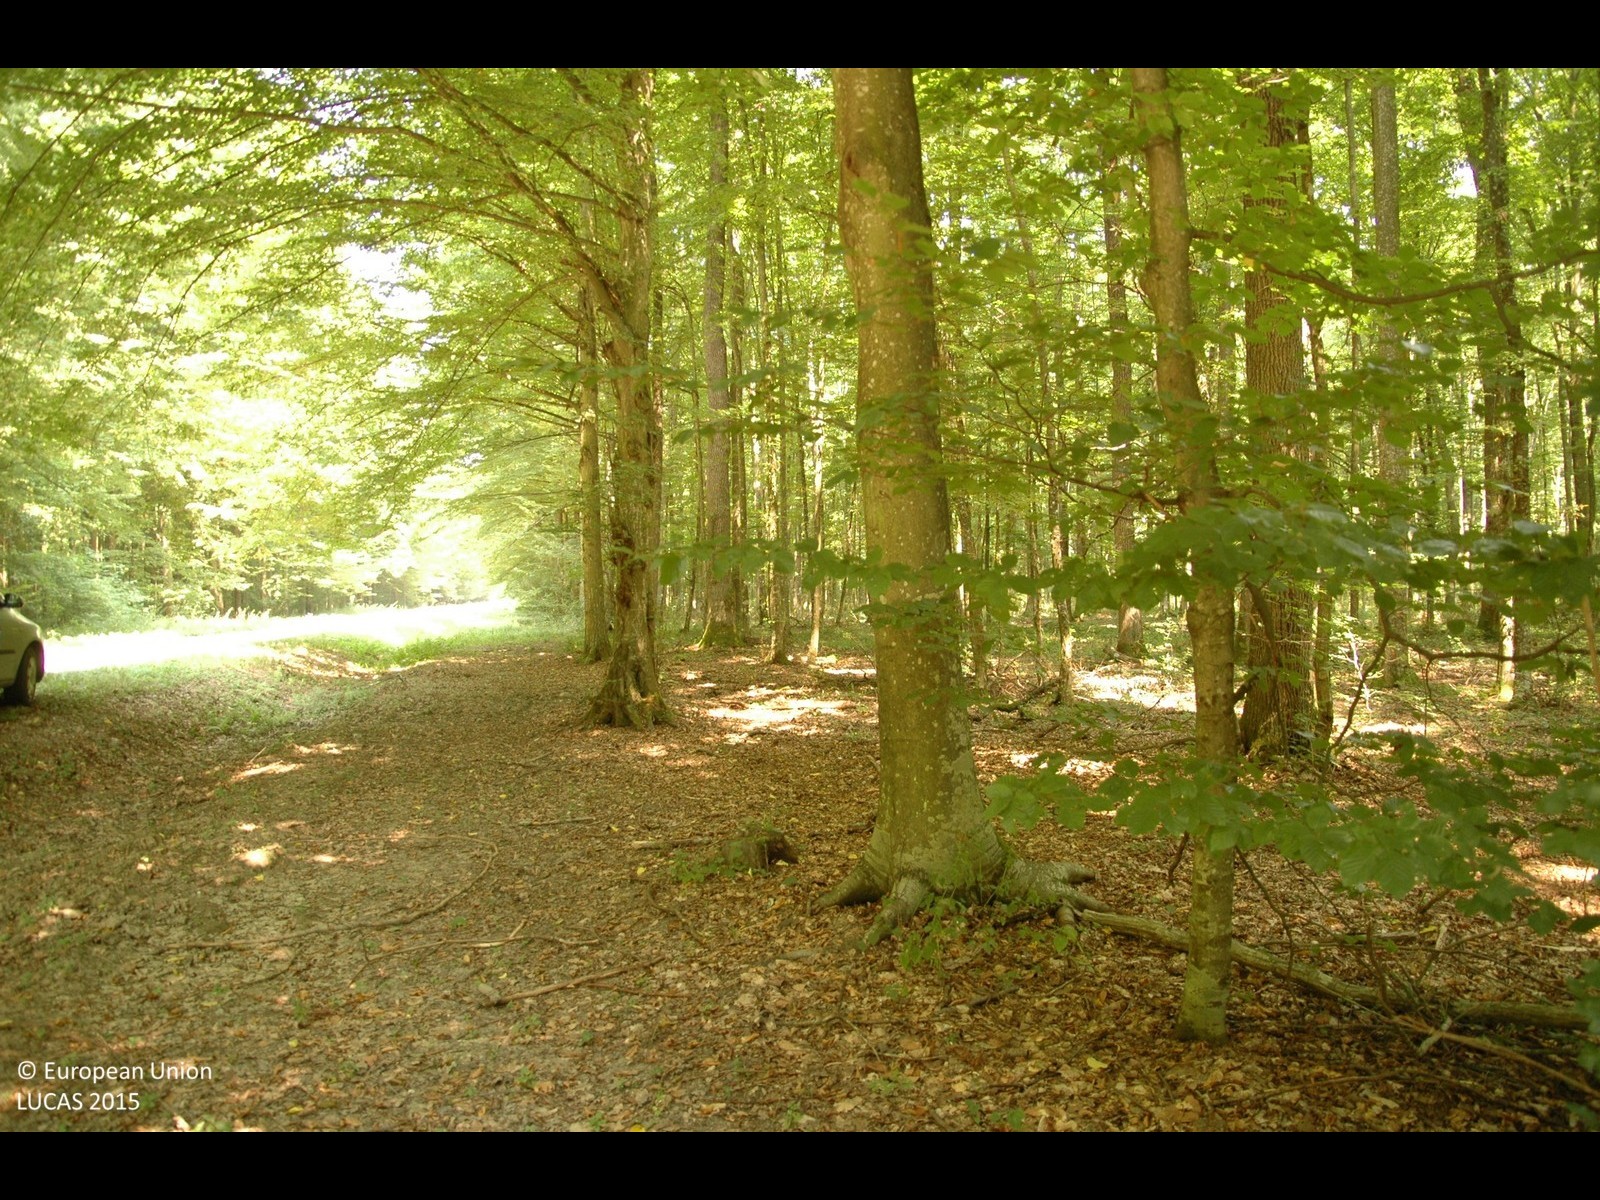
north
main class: Woodland
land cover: Broadleaved woodland
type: mesophytic deciduous forest
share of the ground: > 75 %
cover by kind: broadleaved forest trees 100 %
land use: Forestry
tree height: > 5 m
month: August
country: HR
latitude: 46.0344
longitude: 17.2248
